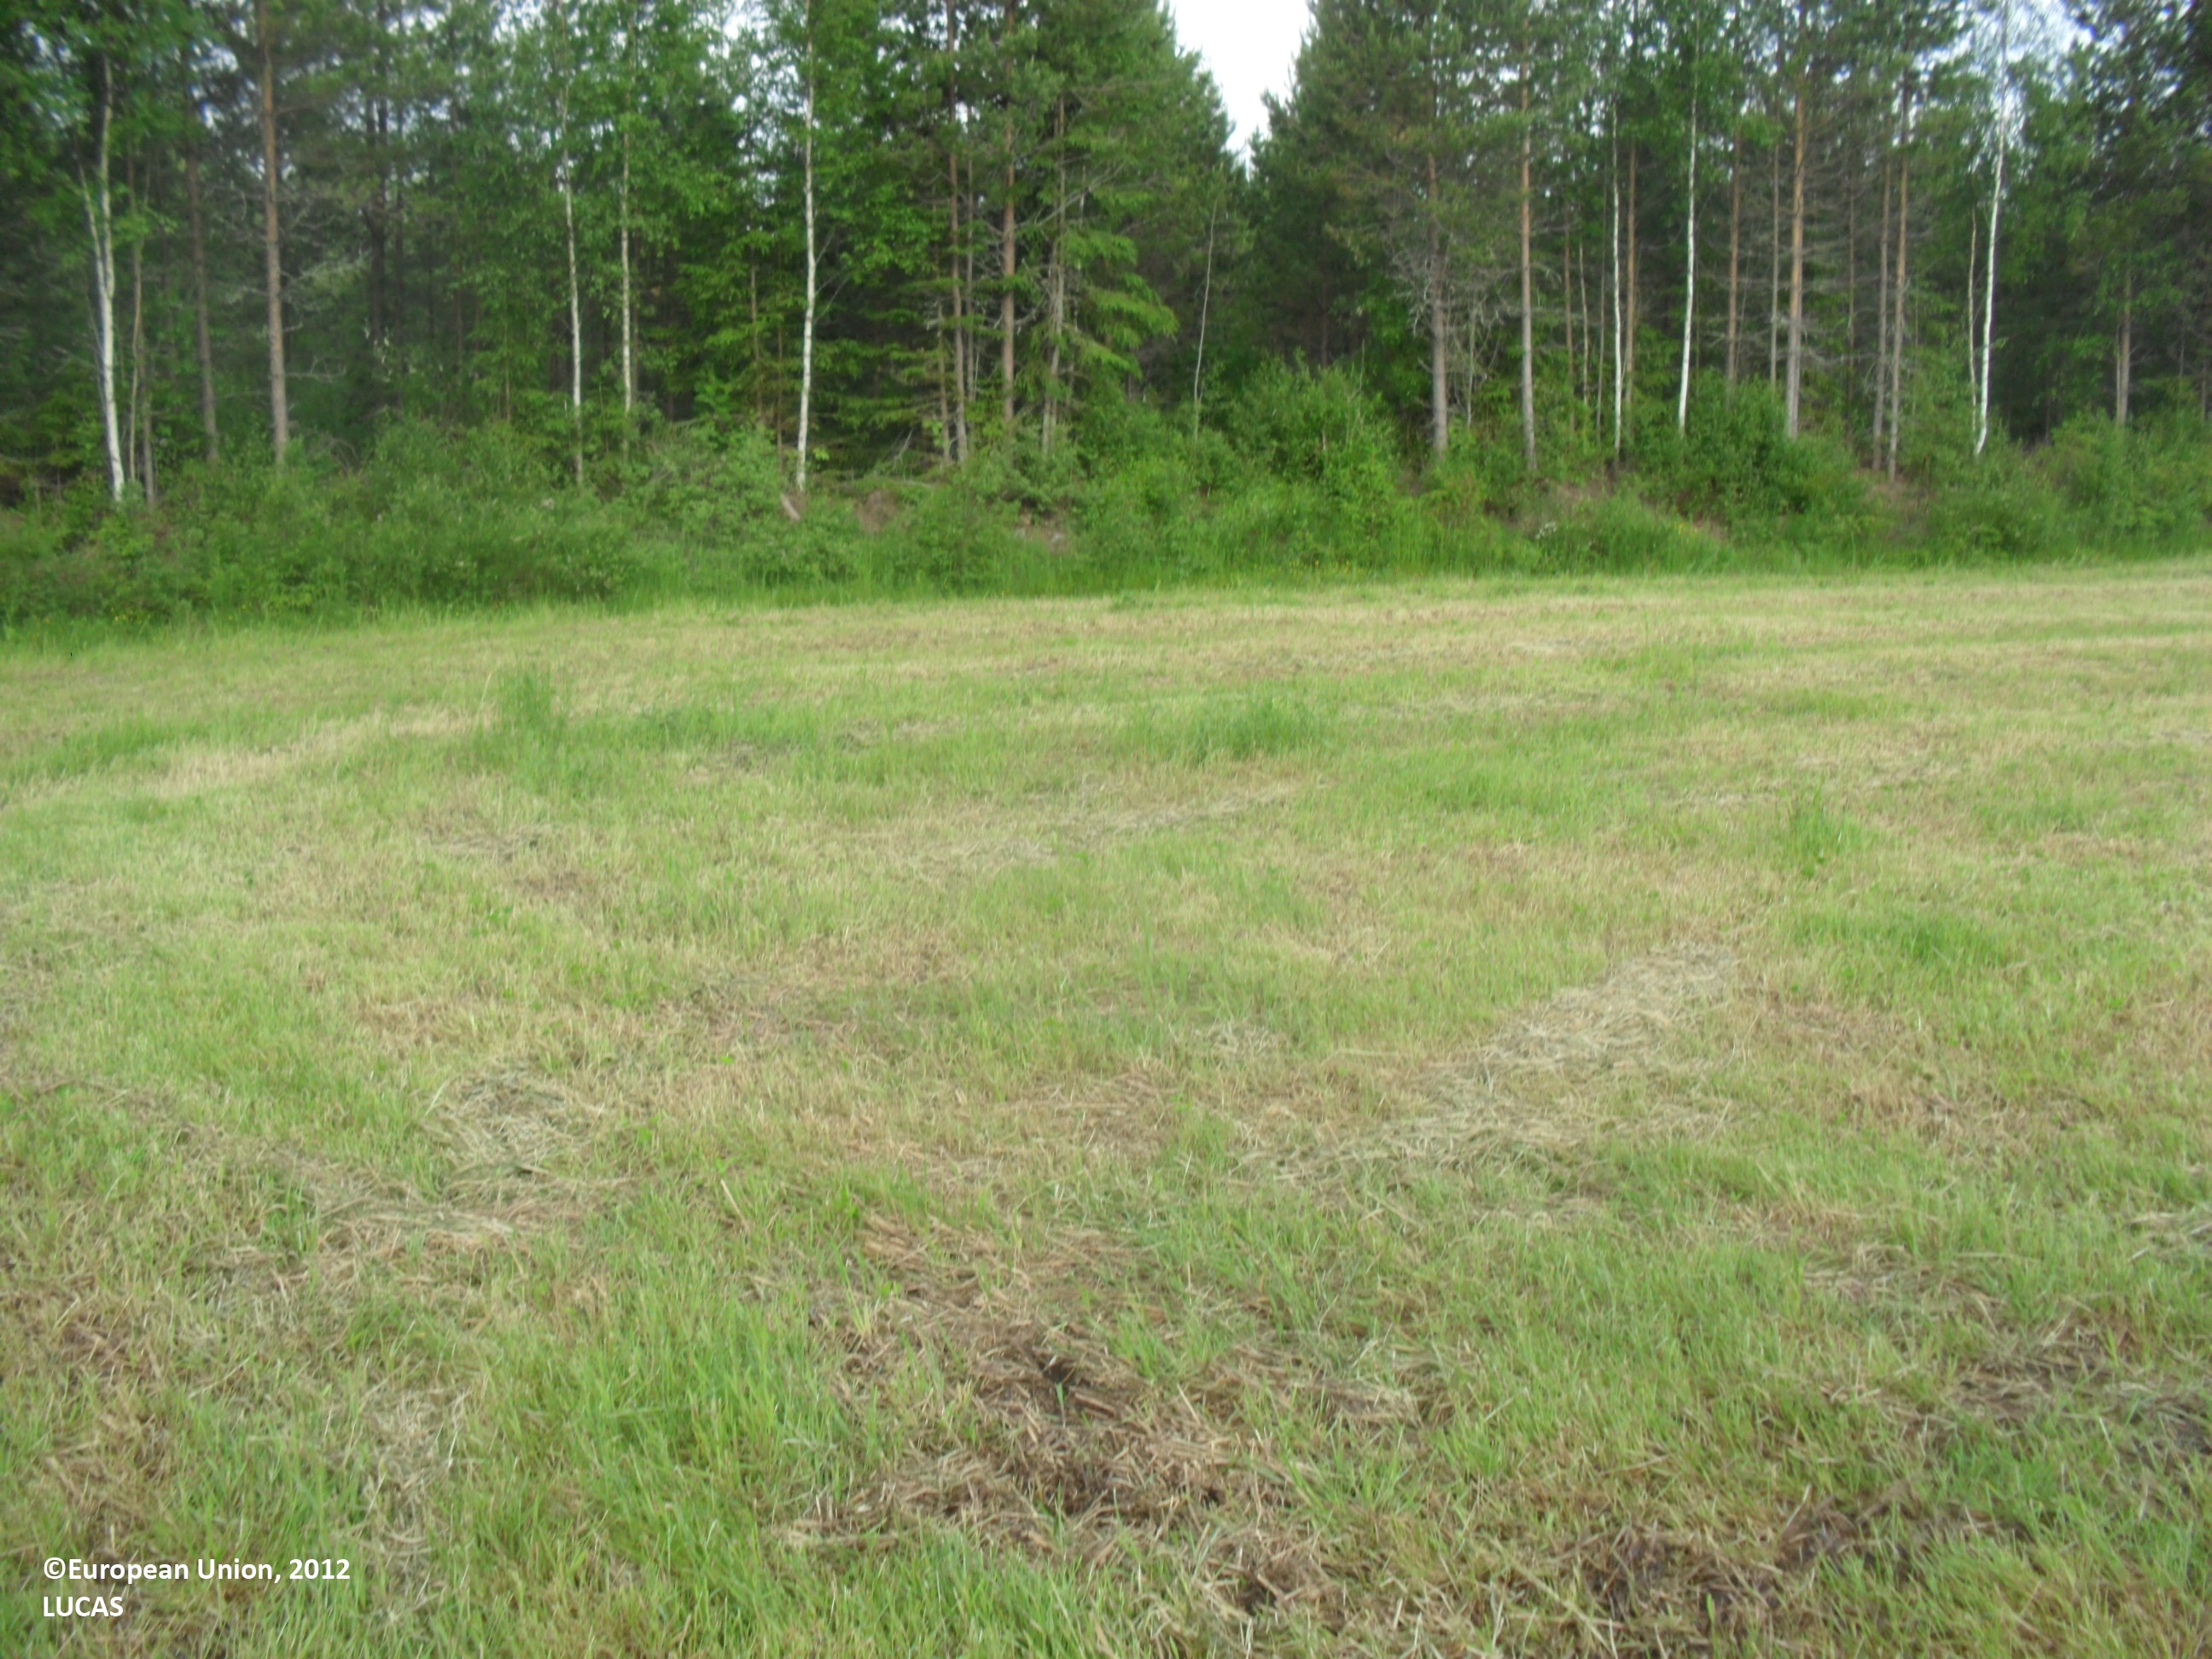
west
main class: Cropland
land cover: Temporary grasslands
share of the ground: > 75 %
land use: Agriculture (excluding fallow land and kitchen gardens)
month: June
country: FI
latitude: 63.3006
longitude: 23.3271
